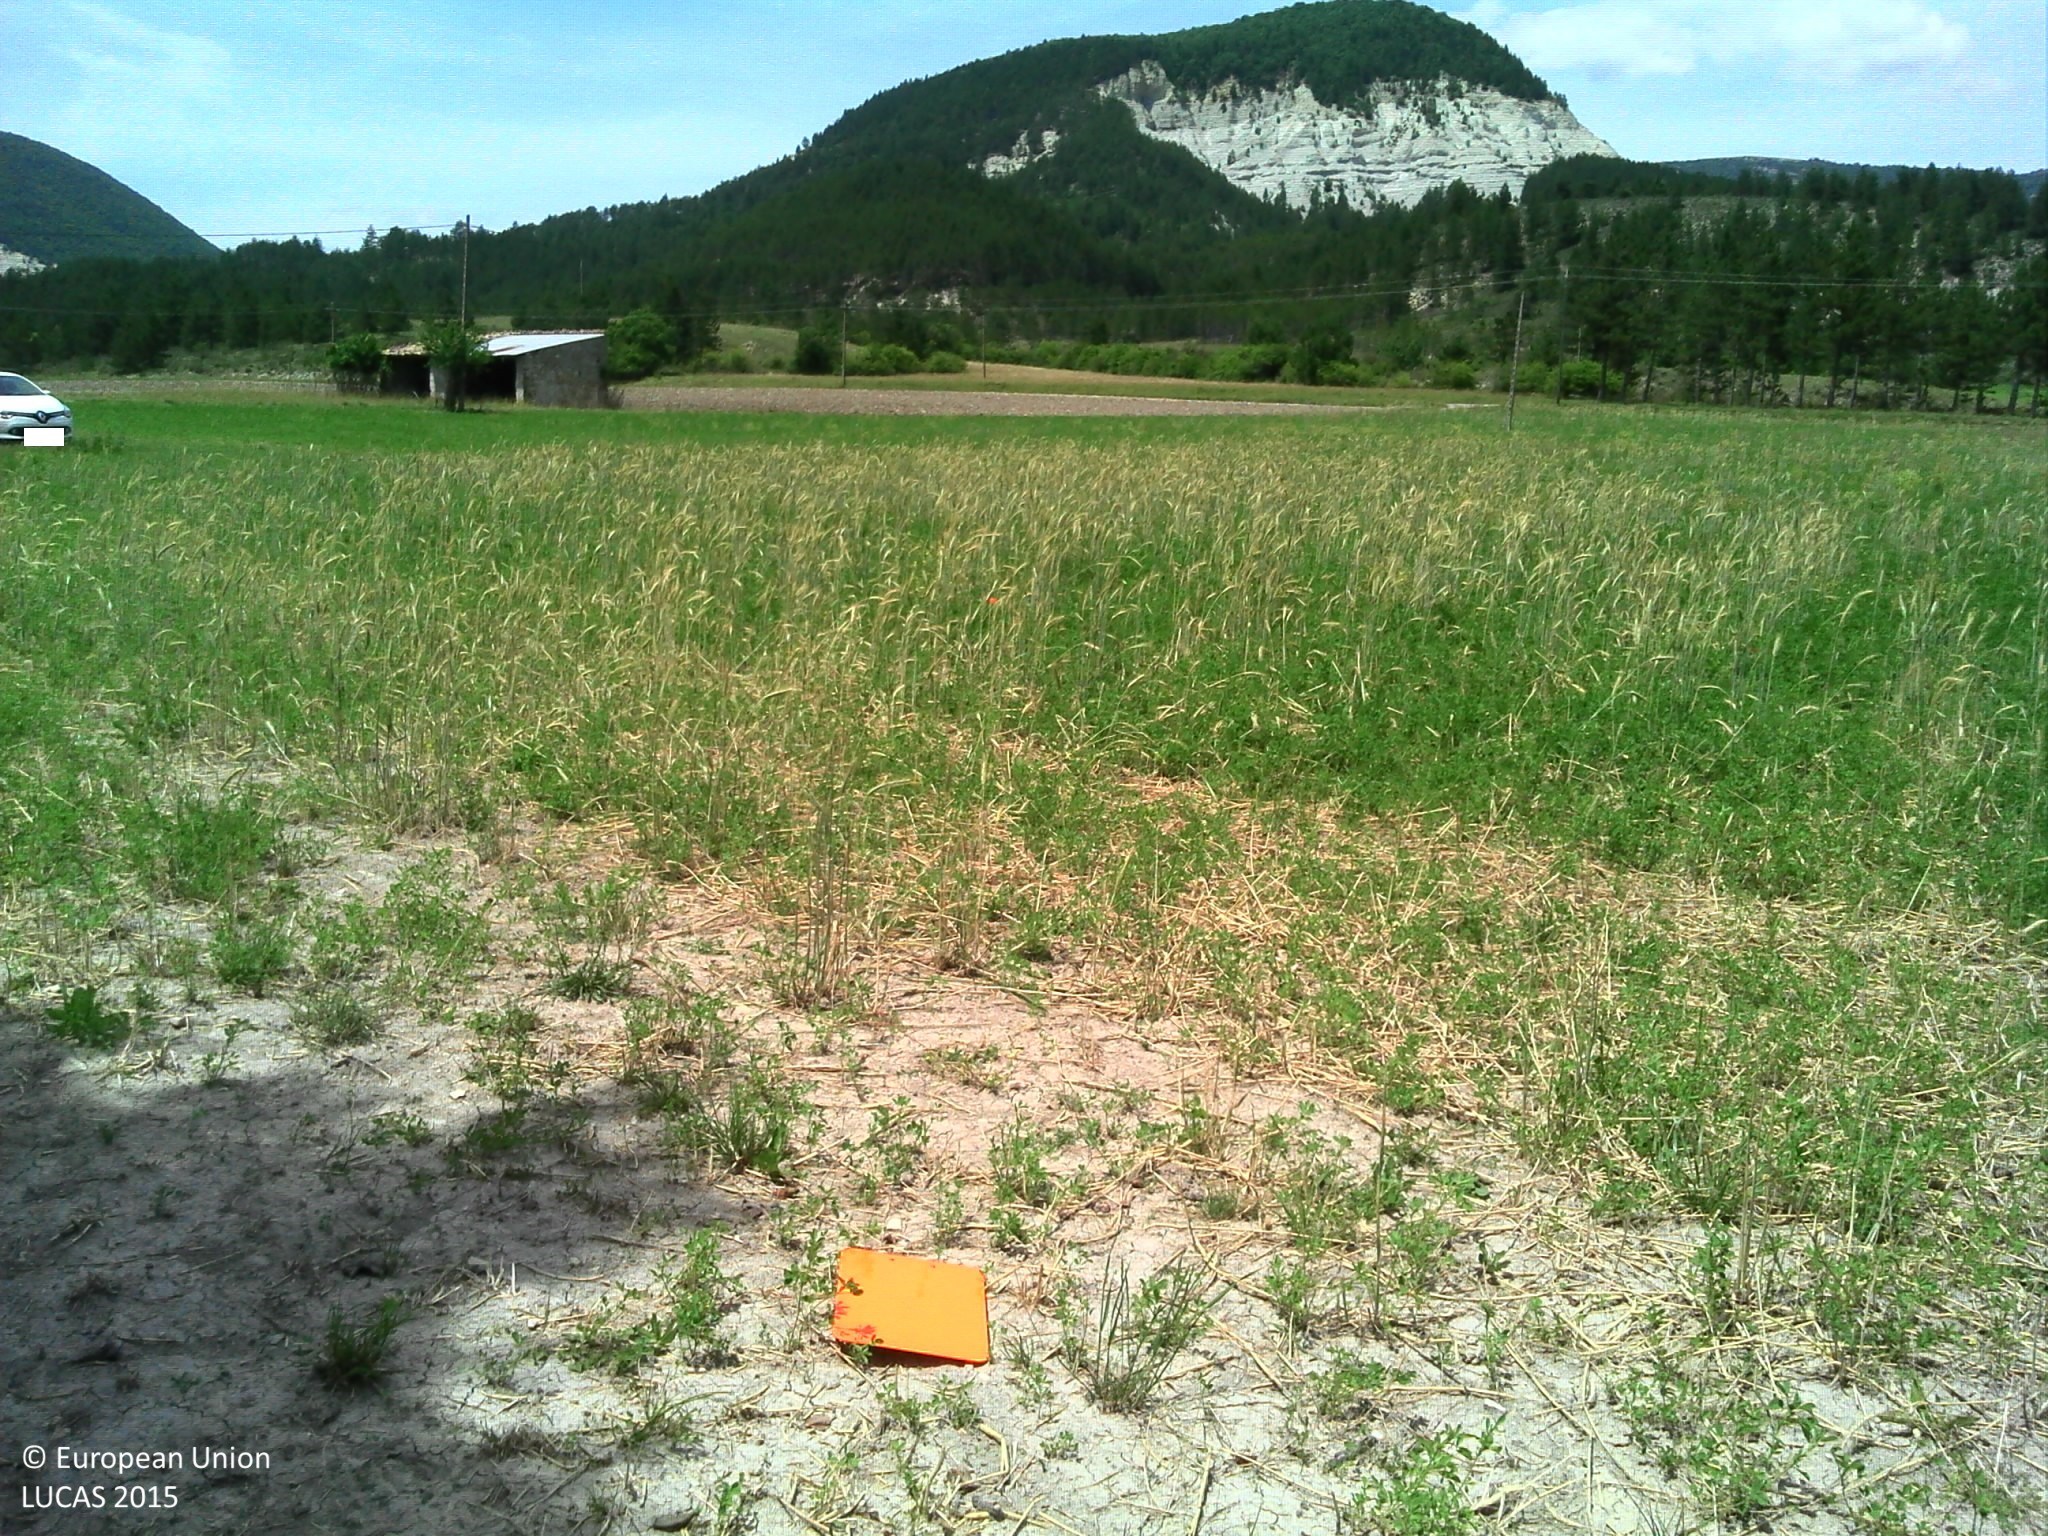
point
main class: Cropland
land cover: Mixed cereals for fodder
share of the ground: > 75 %
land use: Agriculture (excluding fallow land and kitchen gardens)
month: June
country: FR
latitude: 44.2196
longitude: 5.5641
